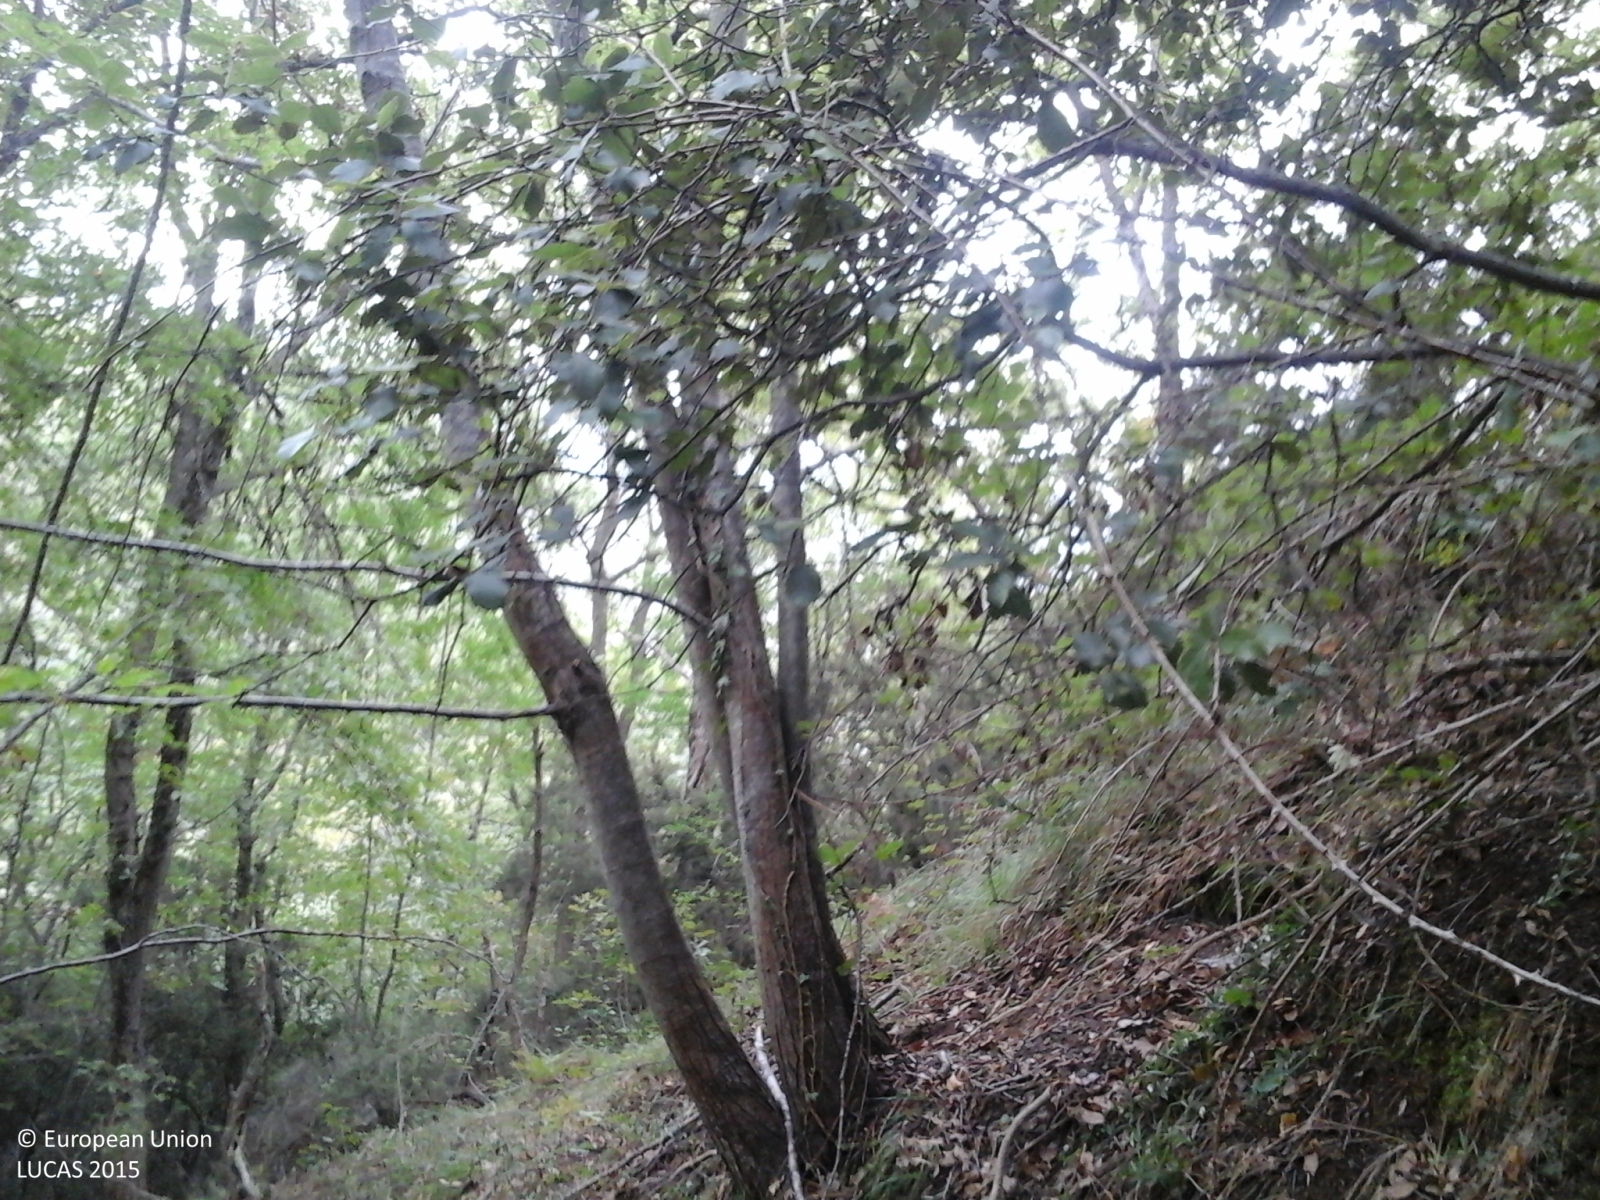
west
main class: Woodland
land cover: Broadleaved woodland
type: thermophilous deciduous forest
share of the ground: > 75 %
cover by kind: broadleaved forest trees 70 %, shrubs 10 %, herbaceous plants 10 %, lichens and mosses 5 %, consolidated bare surface 5 %
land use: Semi-natural and natural areas not in use
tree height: > 5 m
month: October
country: IT
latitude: 44.0074
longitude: 8.0465
